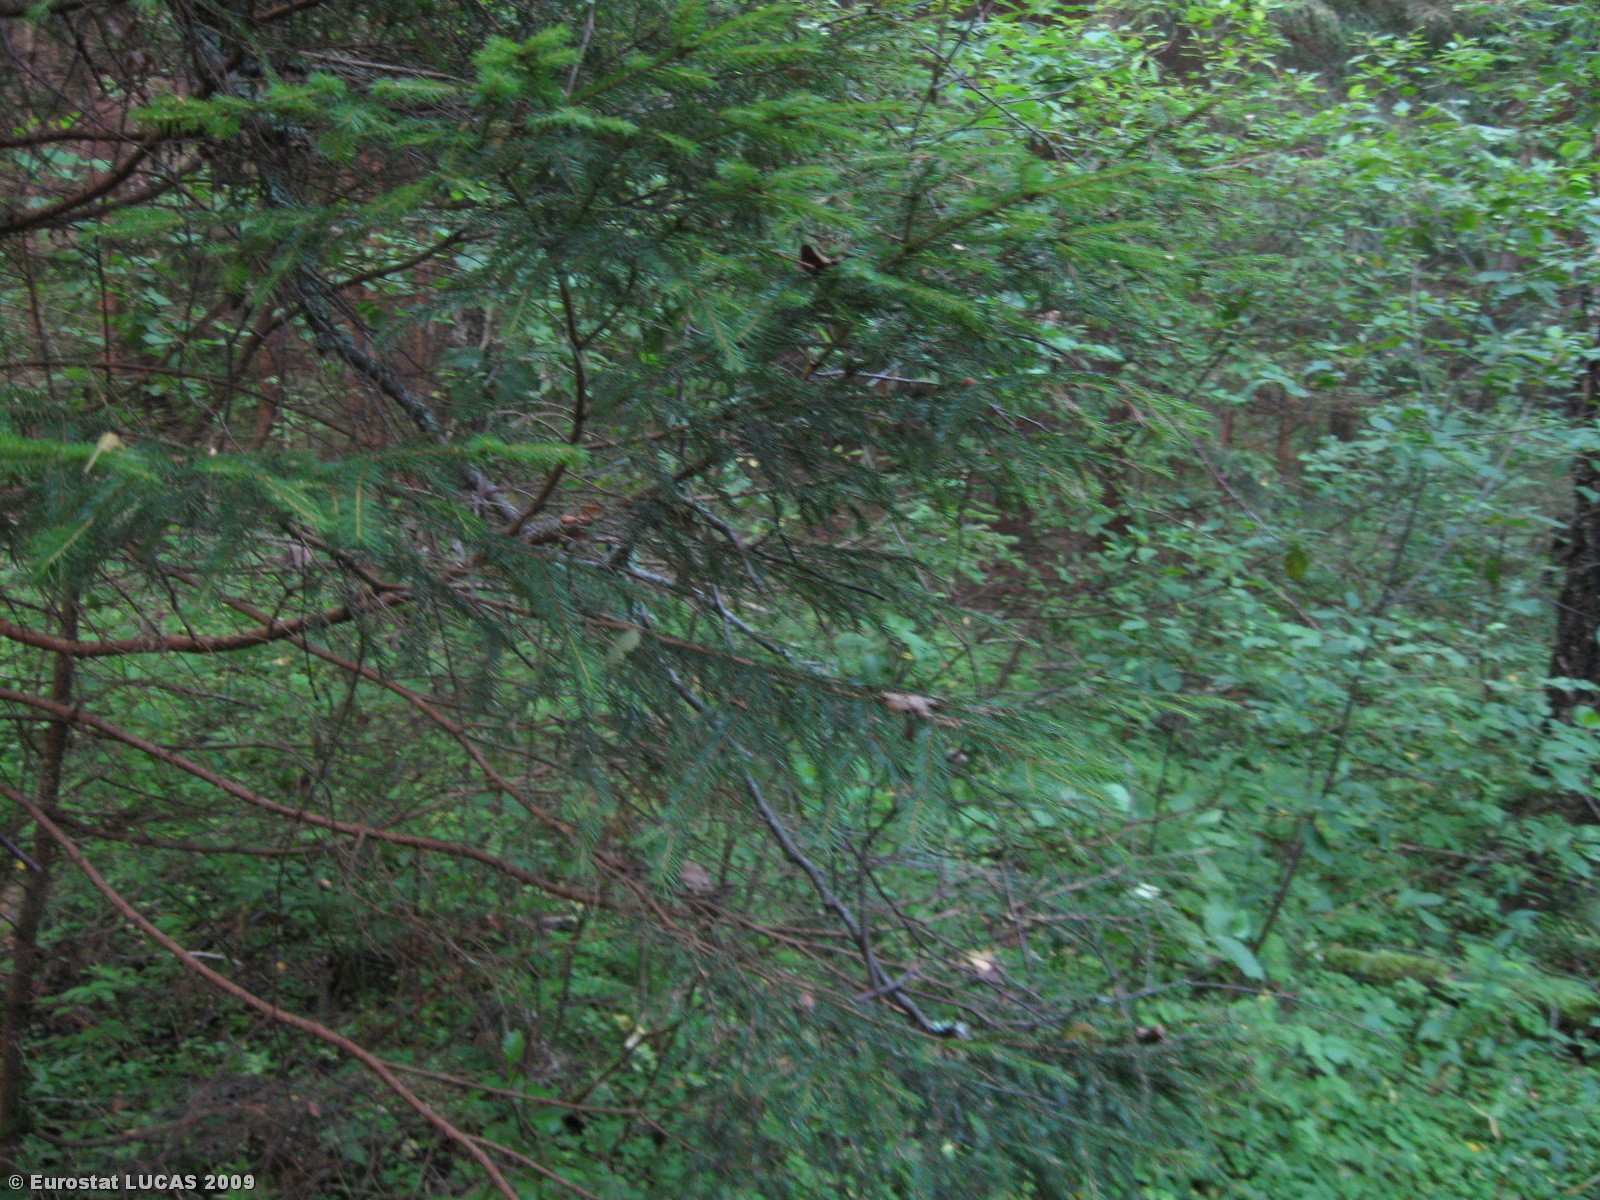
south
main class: Woodland
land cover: Mixed woodland
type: hemiboreal forest and nemoral coniferous forest and mixed broadleaved-coniferous forest
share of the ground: > 75 %
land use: Forestry
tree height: > 5 m
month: August
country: LT
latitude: 55.2504
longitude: 22.6333
